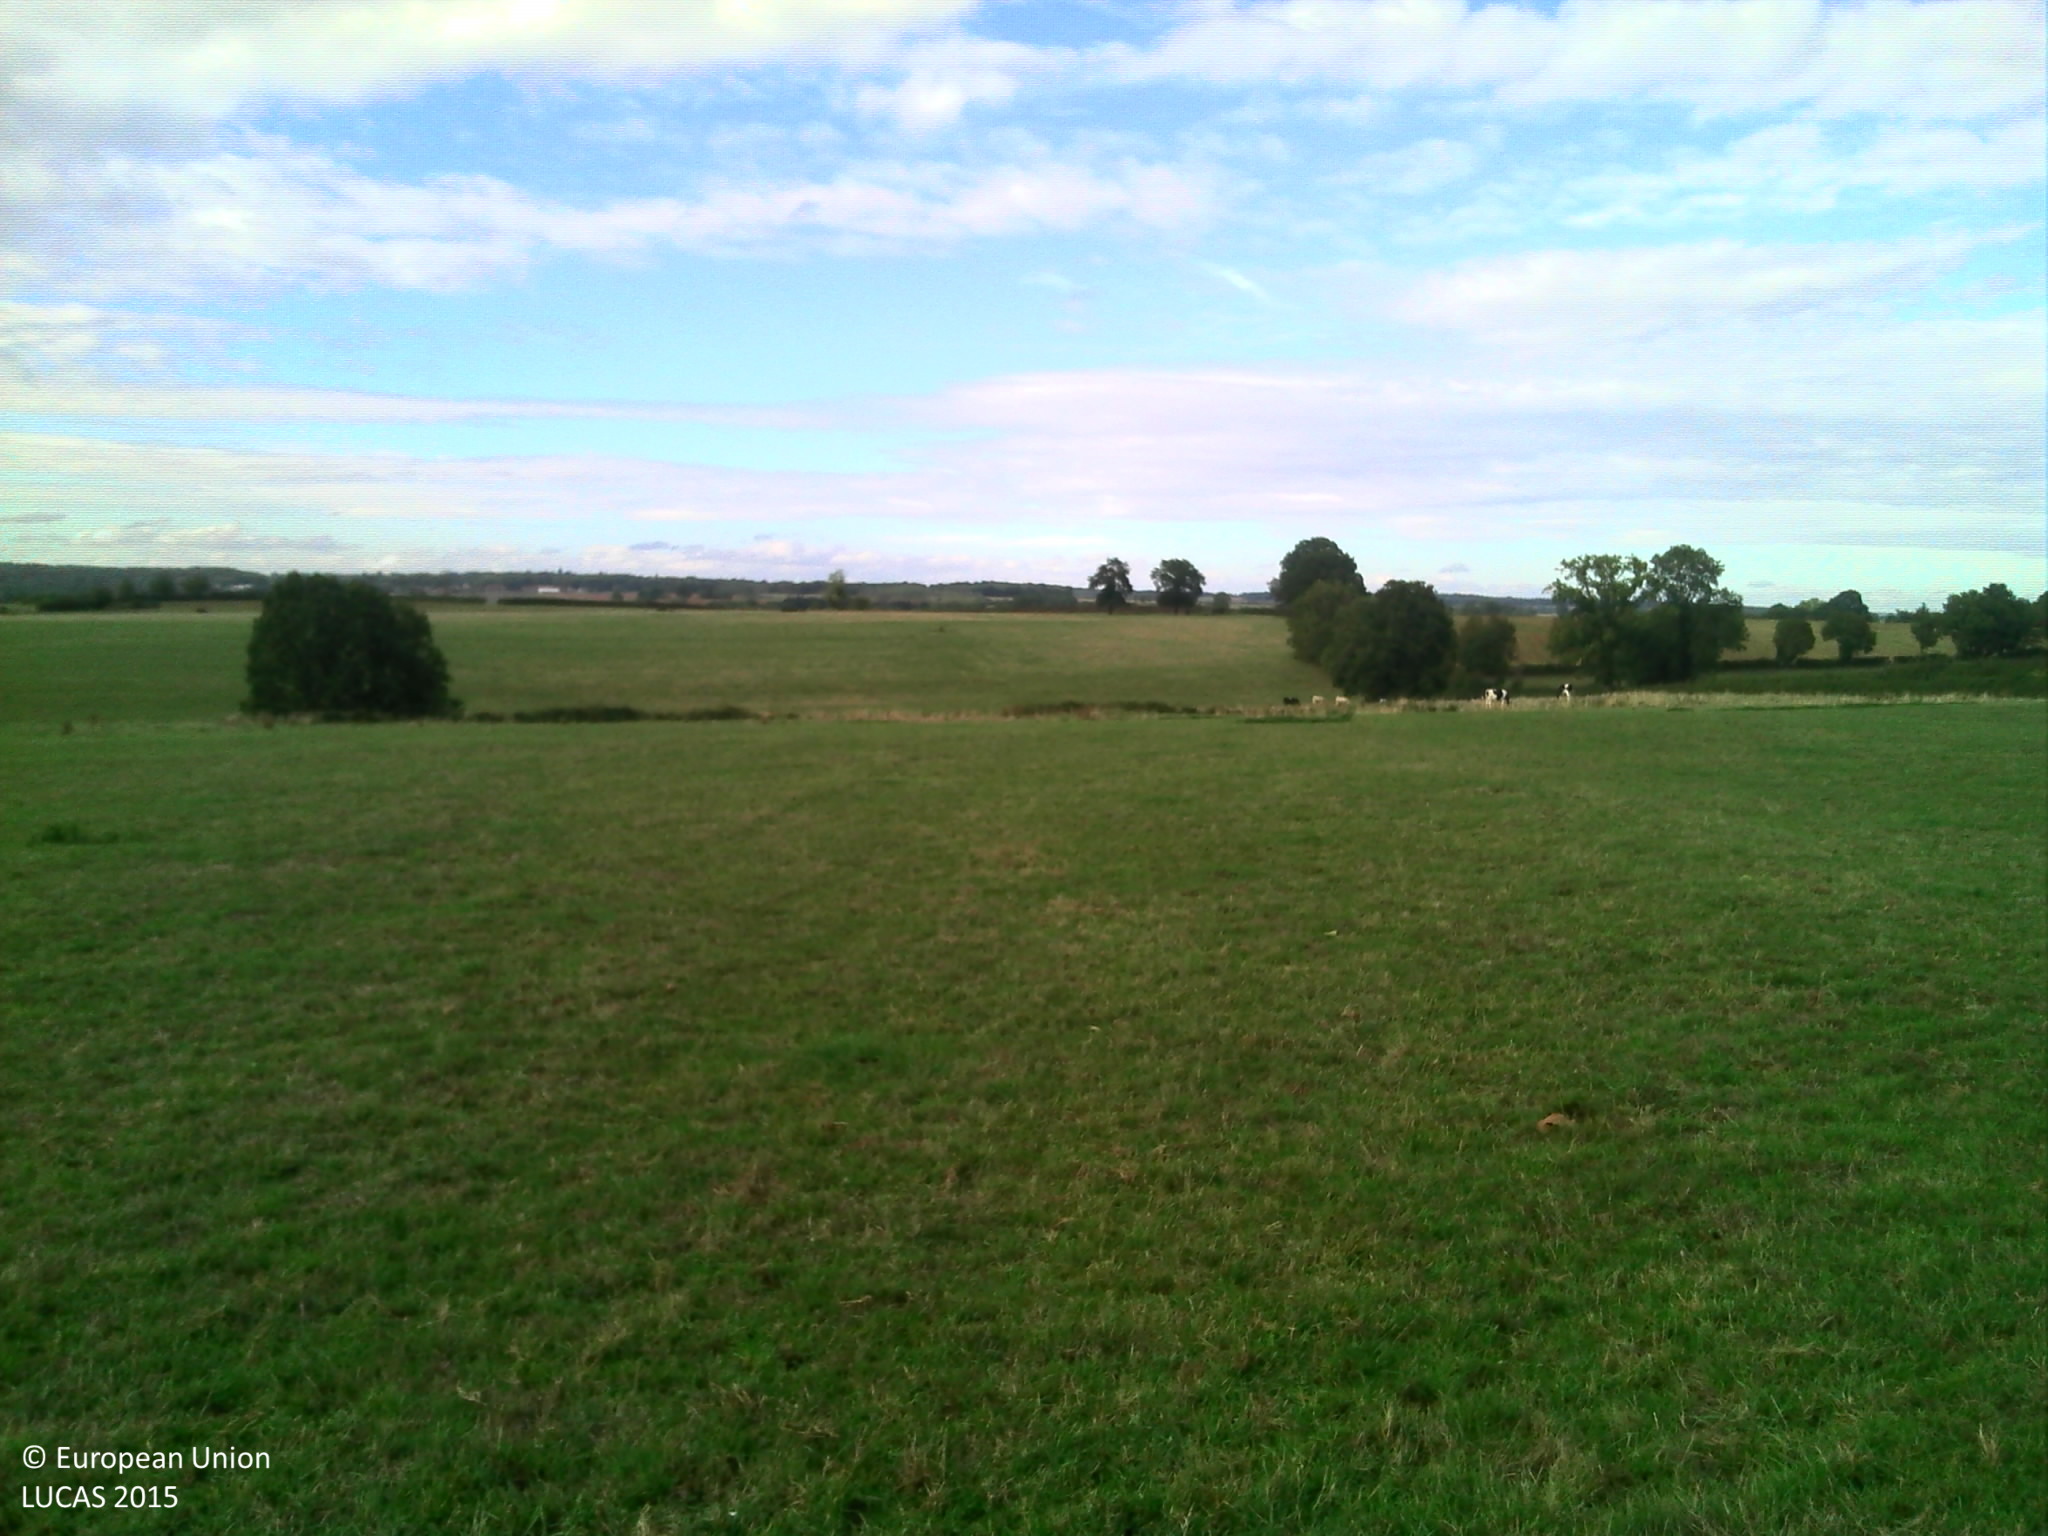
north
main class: Grassland
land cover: Grassland without tree/shrub cover
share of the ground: > 75 %
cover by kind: herbaceous plants 100 %
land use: Agriculture (excluding fallow land and kitchen gardens)
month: September
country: FR
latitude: 47.3913
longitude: 4.3155
